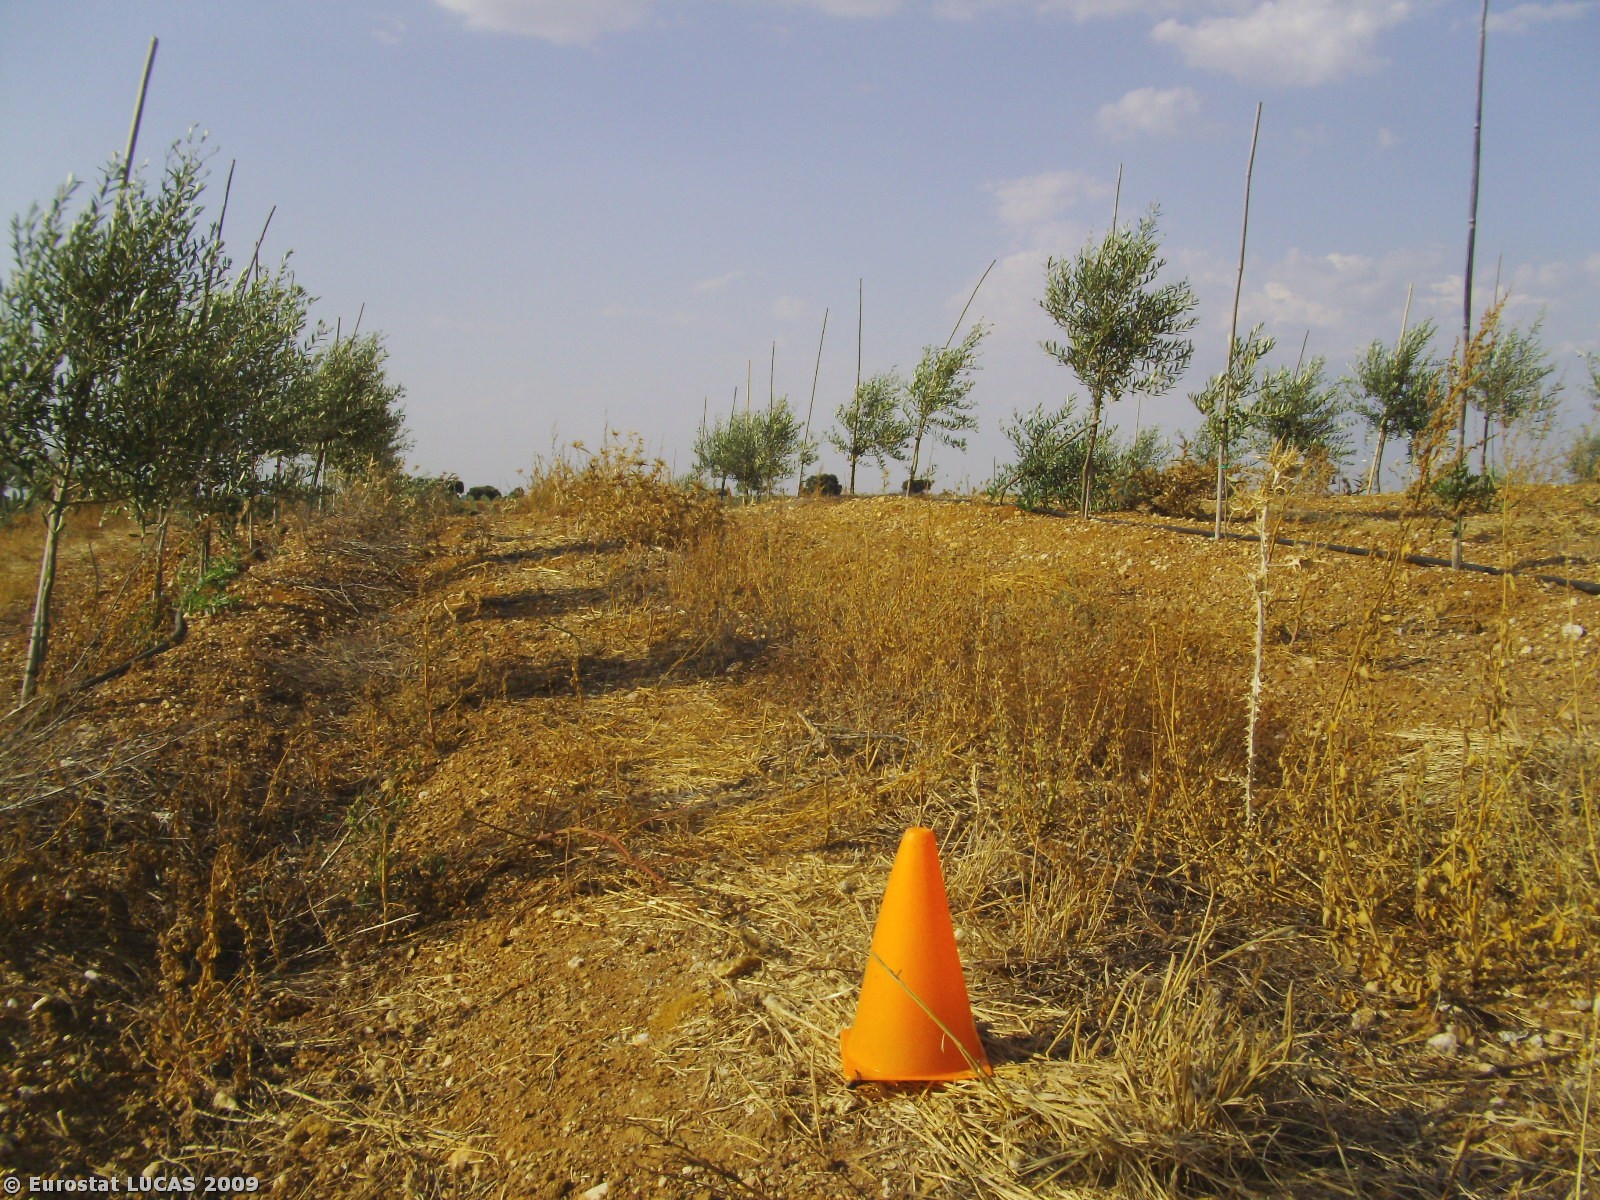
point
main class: Cropland
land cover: Olive groves
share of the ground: 50 - 75 %
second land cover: Spontaneously vegetated surfaces
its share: > 75 %
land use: Agriculture (excluding fallow land and kitchen gardens)
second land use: Fallow land
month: August
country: PT
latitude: 37.8762
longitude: -8.3286
